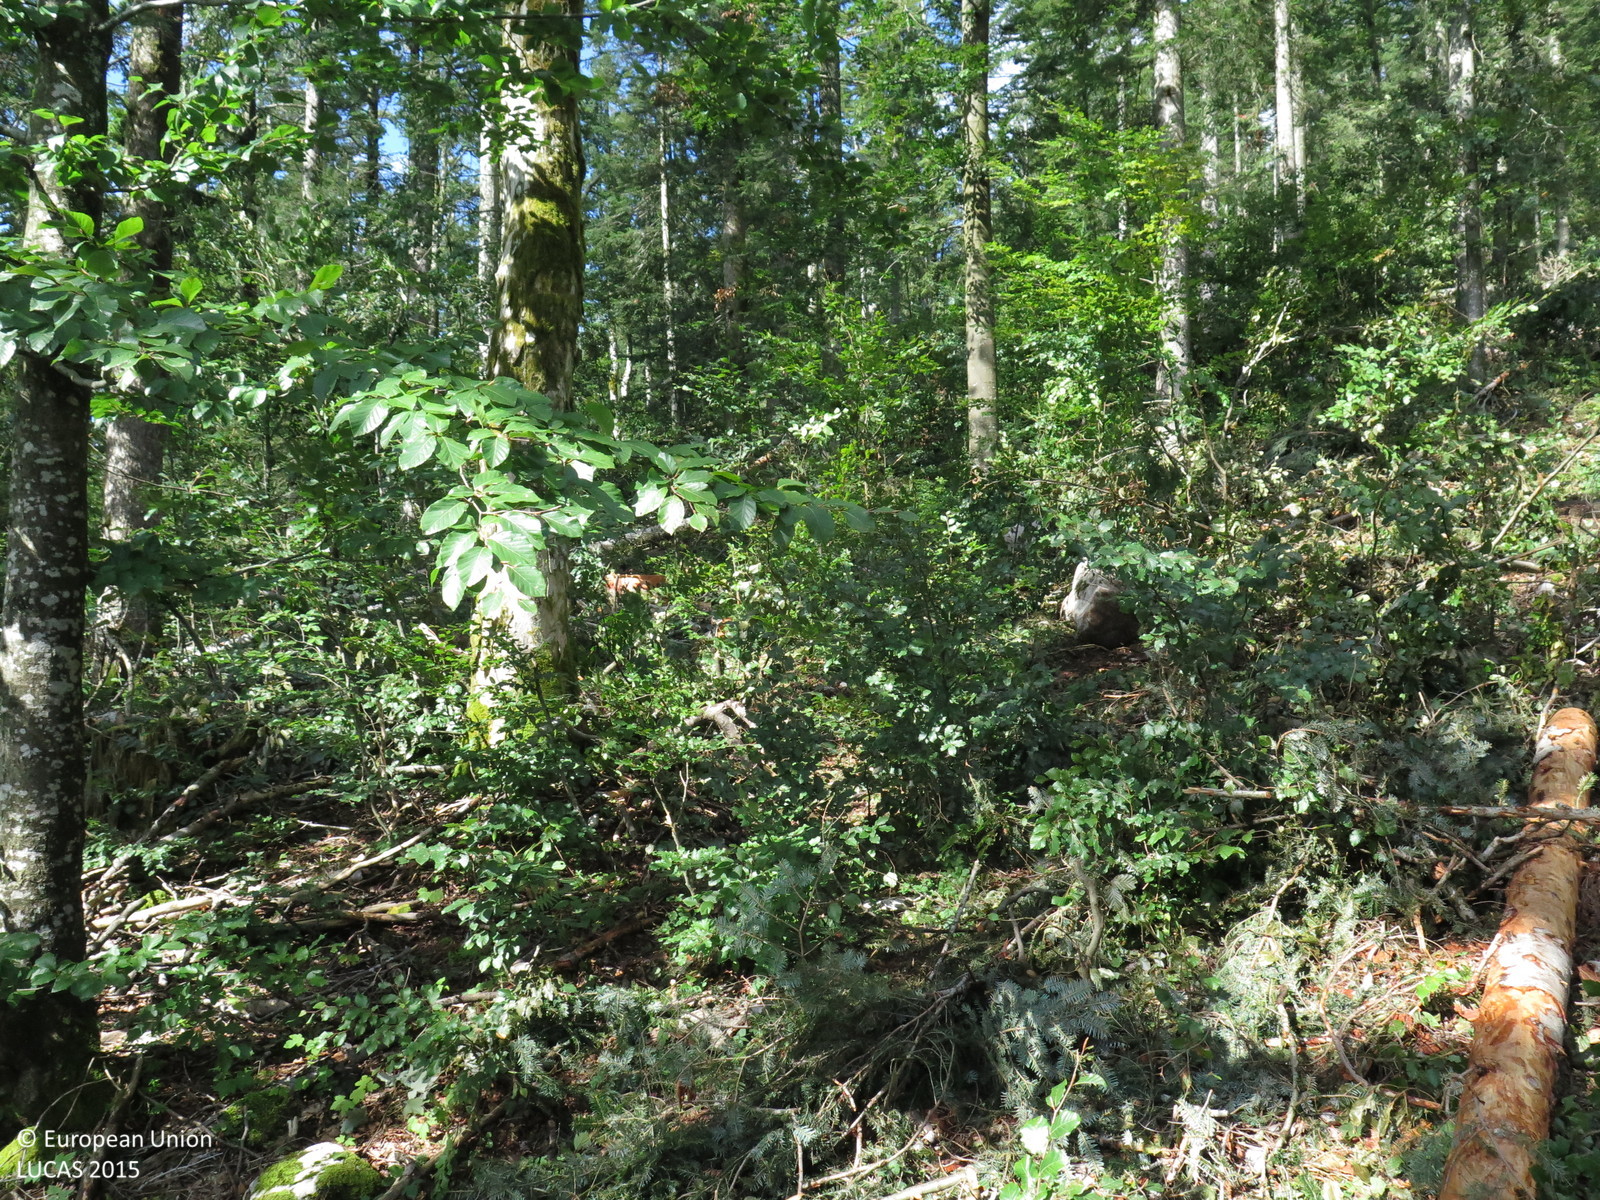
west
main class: Woodland
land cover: Other mixed woodland
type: mountainous beech forest
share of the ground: > 75 %
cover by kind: broadleaved forest trees 75 %, coniferous forest trees 25 %
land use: Forestry
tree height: > 5 m
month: September
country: HR
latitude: 45.4758
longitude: 14.6133
